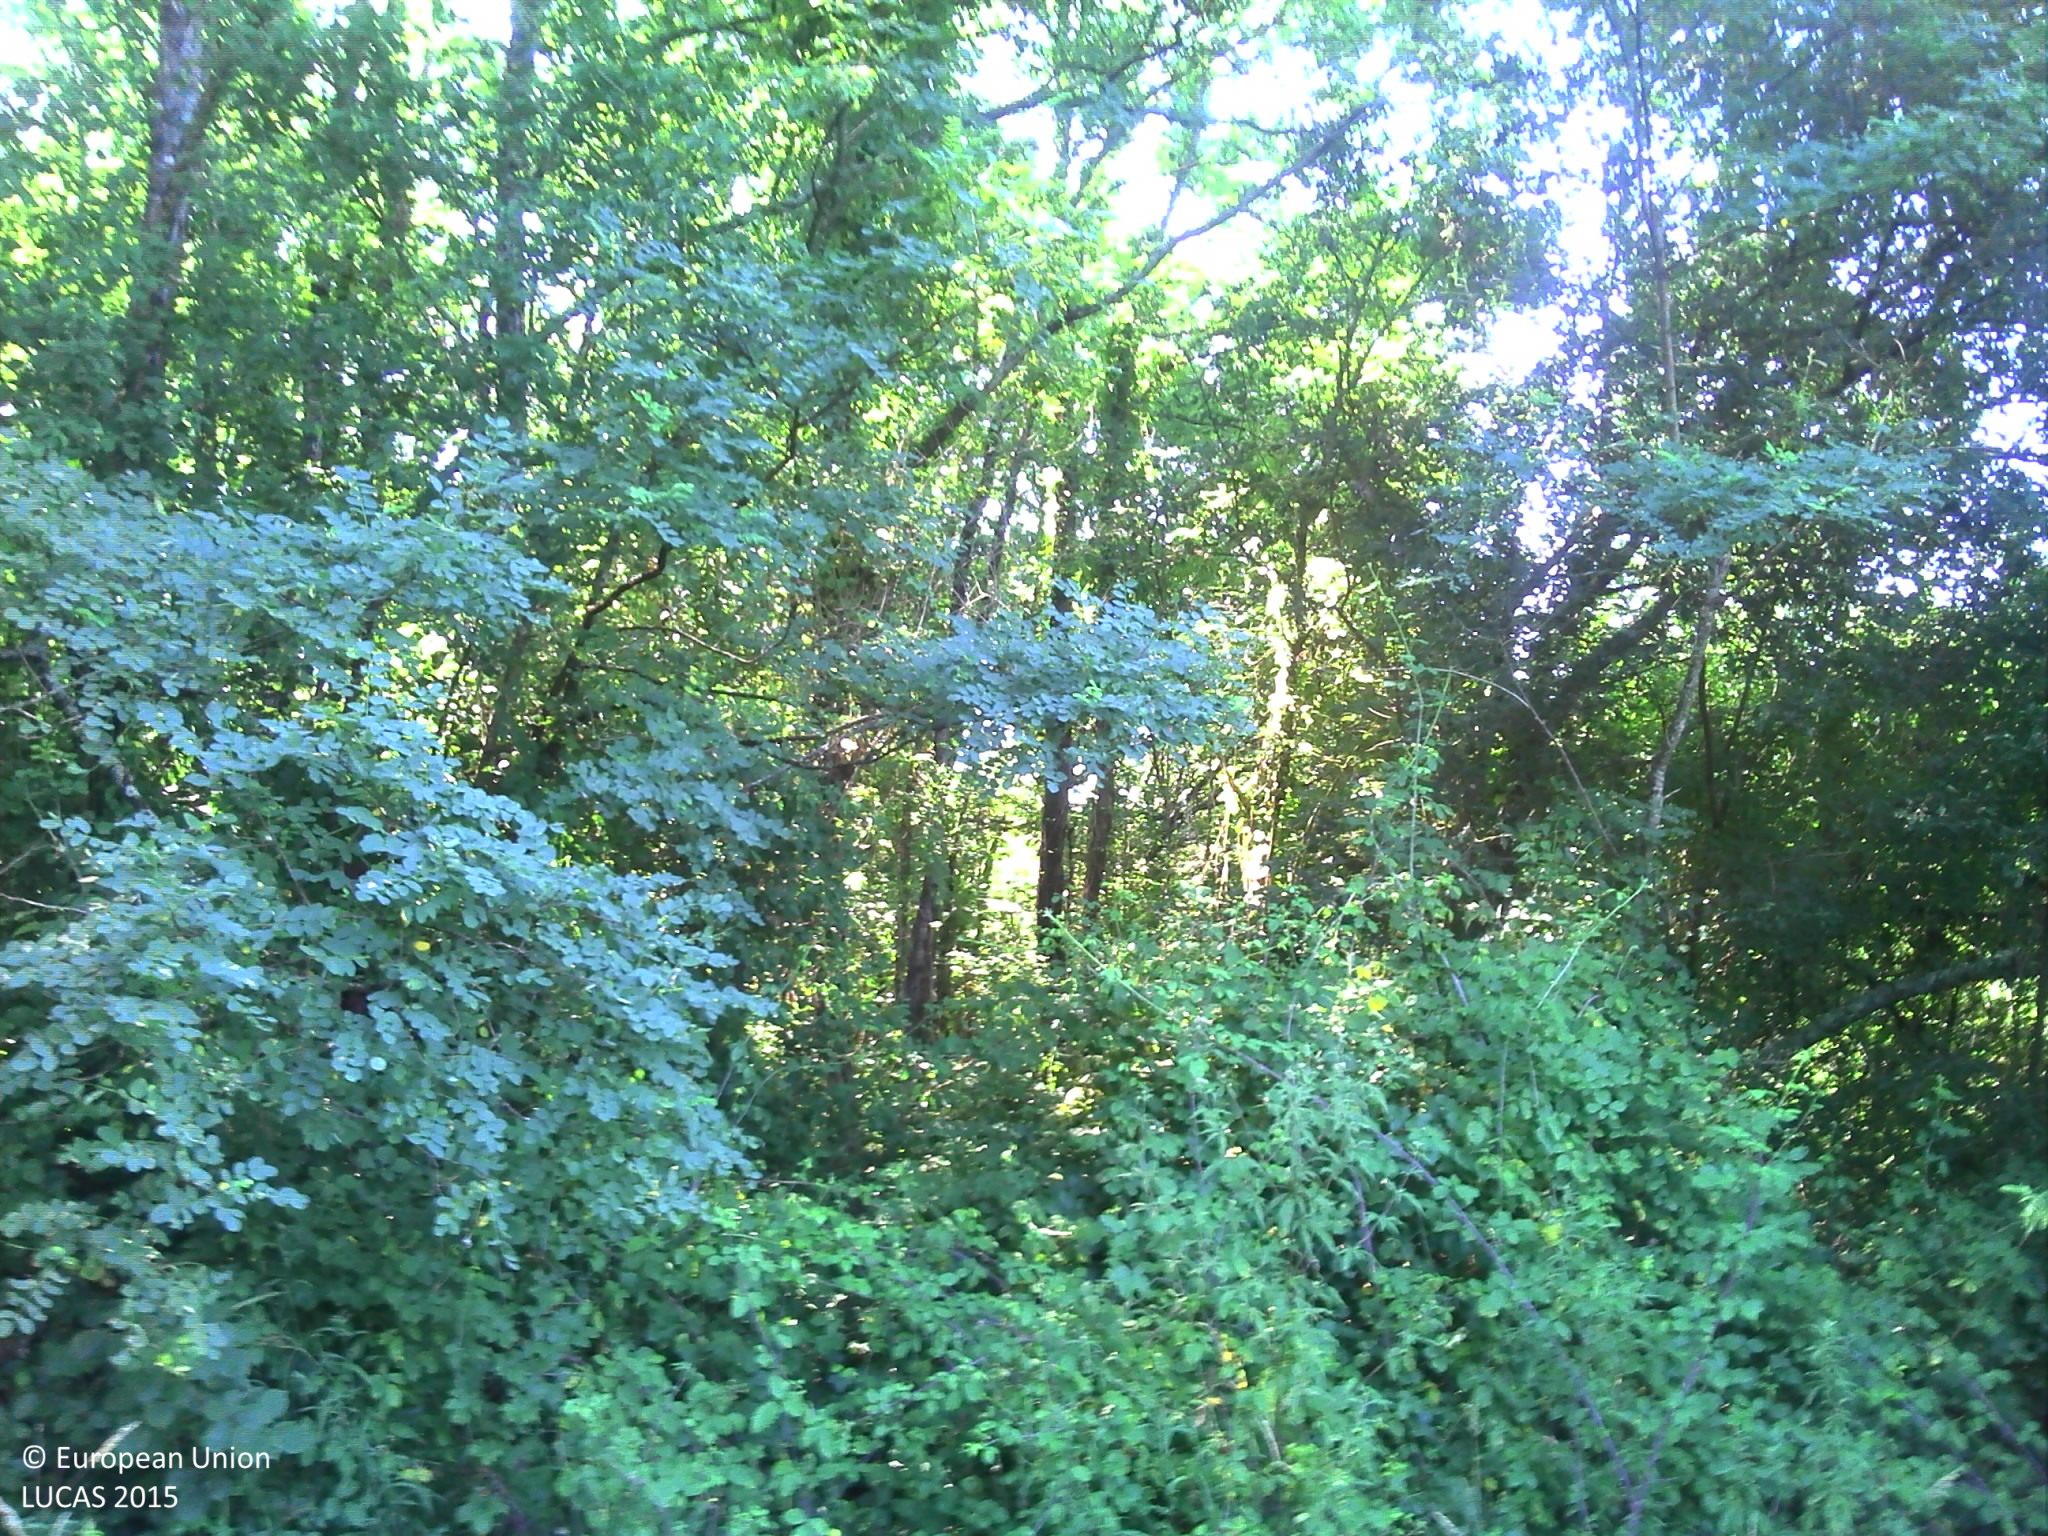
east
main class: Shrubland
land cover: Shrubland with sparse tree cover
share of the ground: > 75 %
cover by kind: shrubs 60 %, herbaceous plants 35 %, broadleaved forest trees 5 %
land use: Semi-natural and natural areas not in use
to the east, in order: Shrubland with sparse tree cover; Lines of trees; Tracks; Abandoned hedges; Grassland without tree/shrub cover; Broadleaved woodland; Ditches and canals; Broadleaved woodland; Ditches and canals; Broadleaved woodland
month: July
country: FR
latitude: 43.5893
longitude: -1.1005
